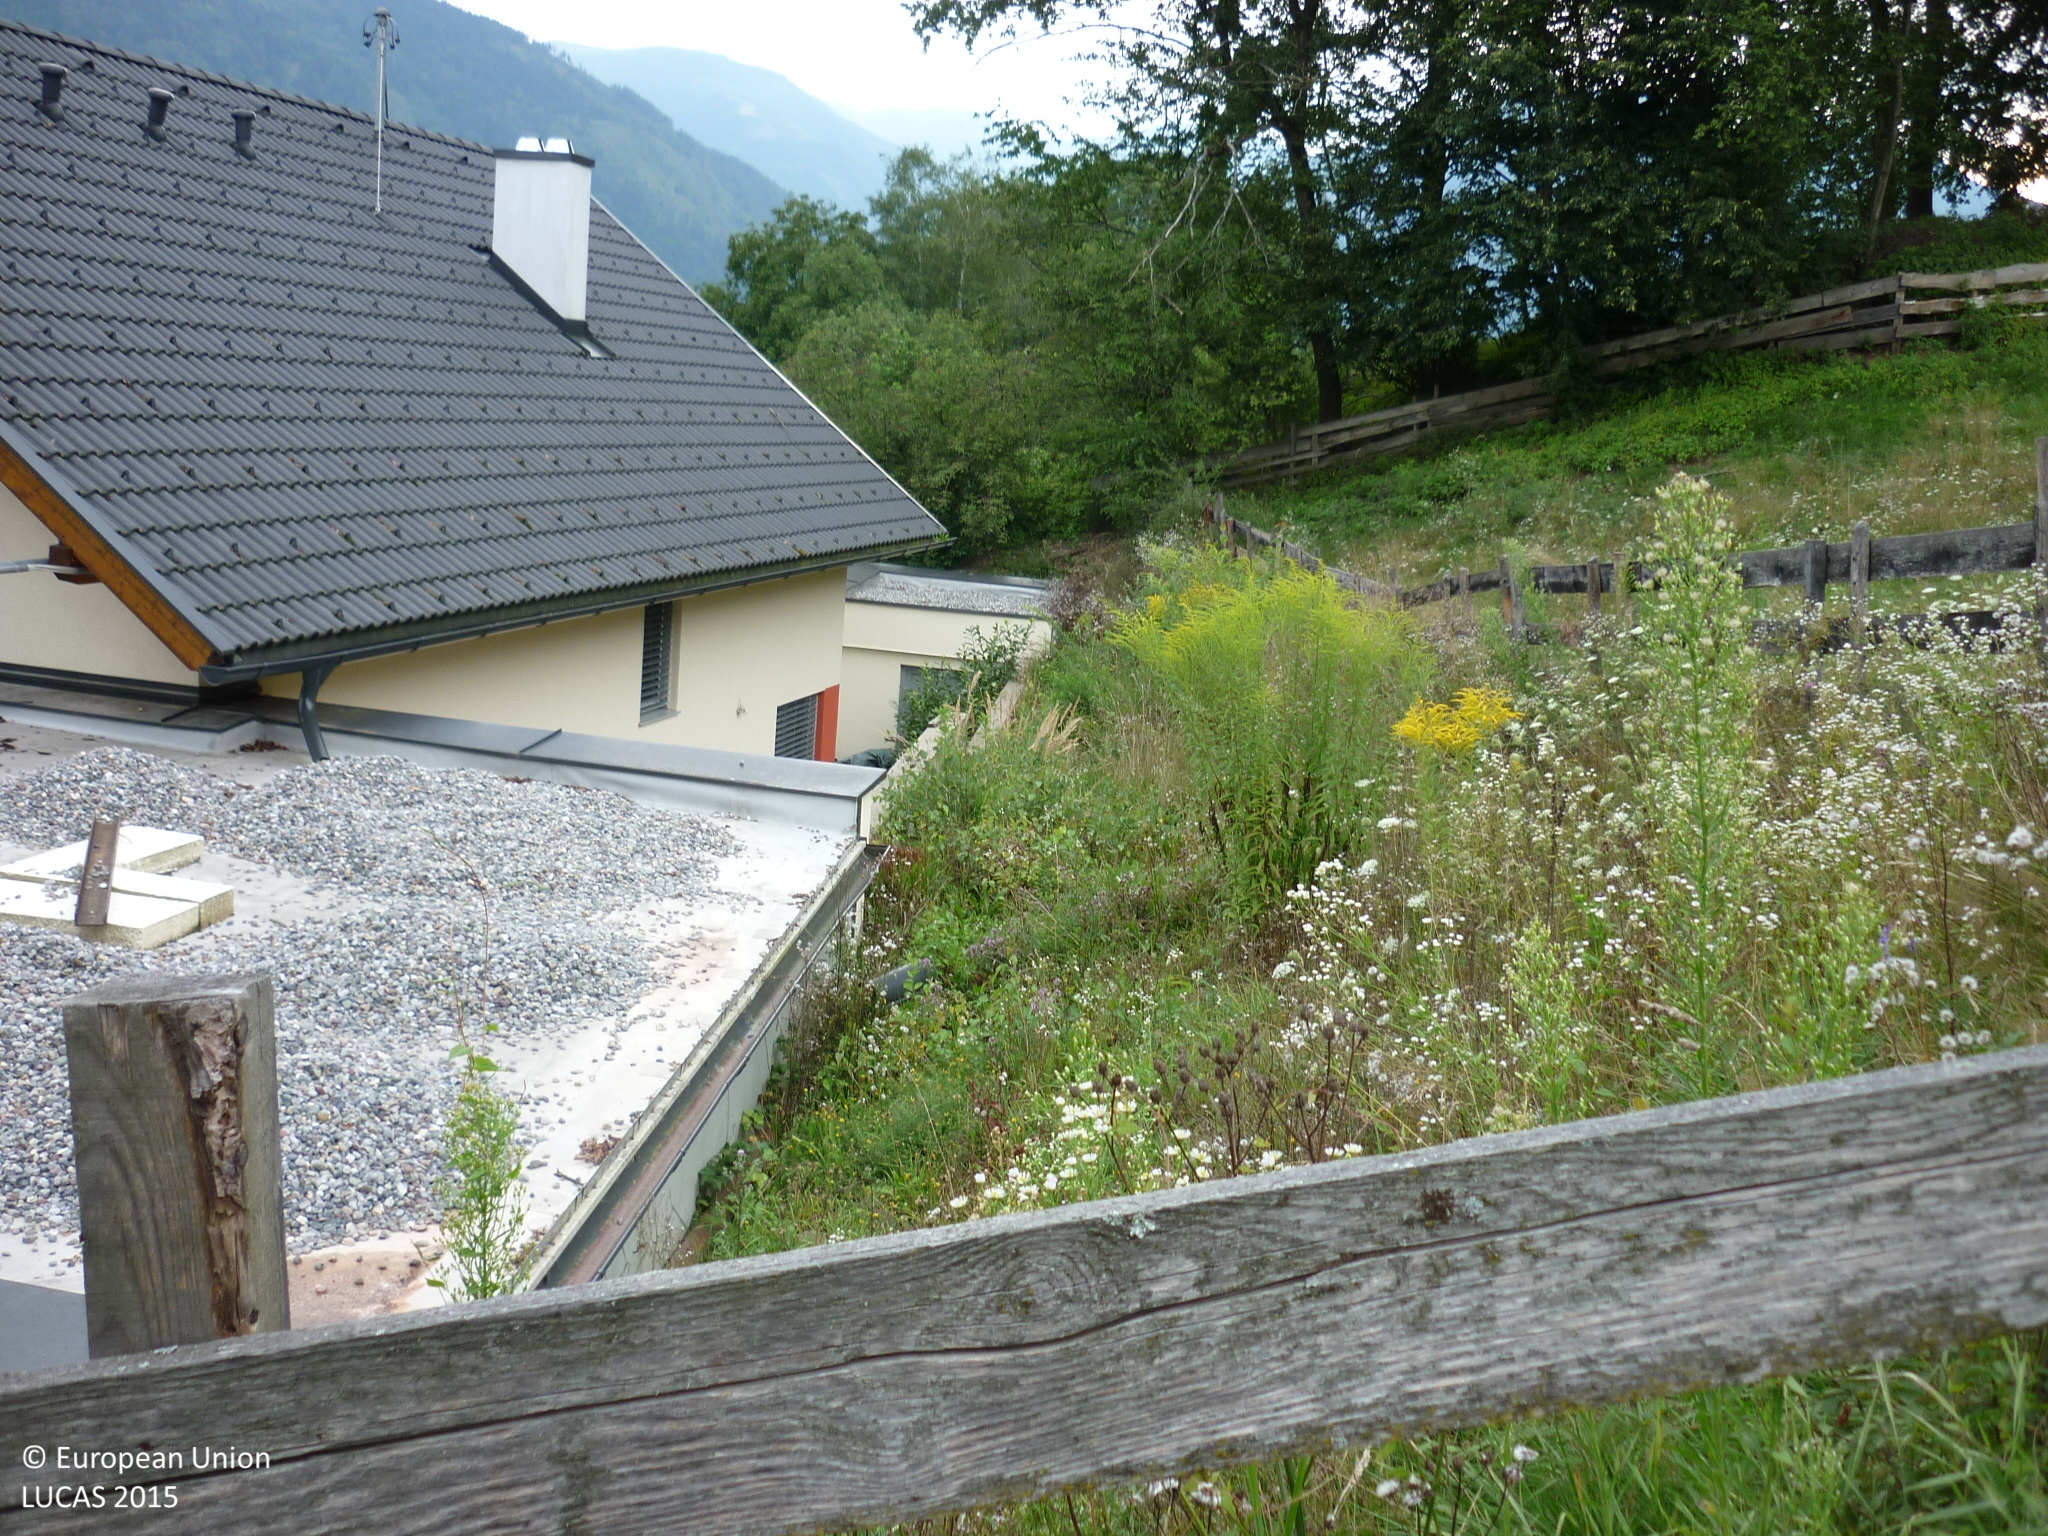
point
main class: Grassland
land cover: Spontaneously vegetated surfaces
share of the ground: > 75 %
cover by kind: herbaceous plants 100 %
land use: Residential
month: August
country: AT
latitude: 46.8373
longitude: 13.4196
